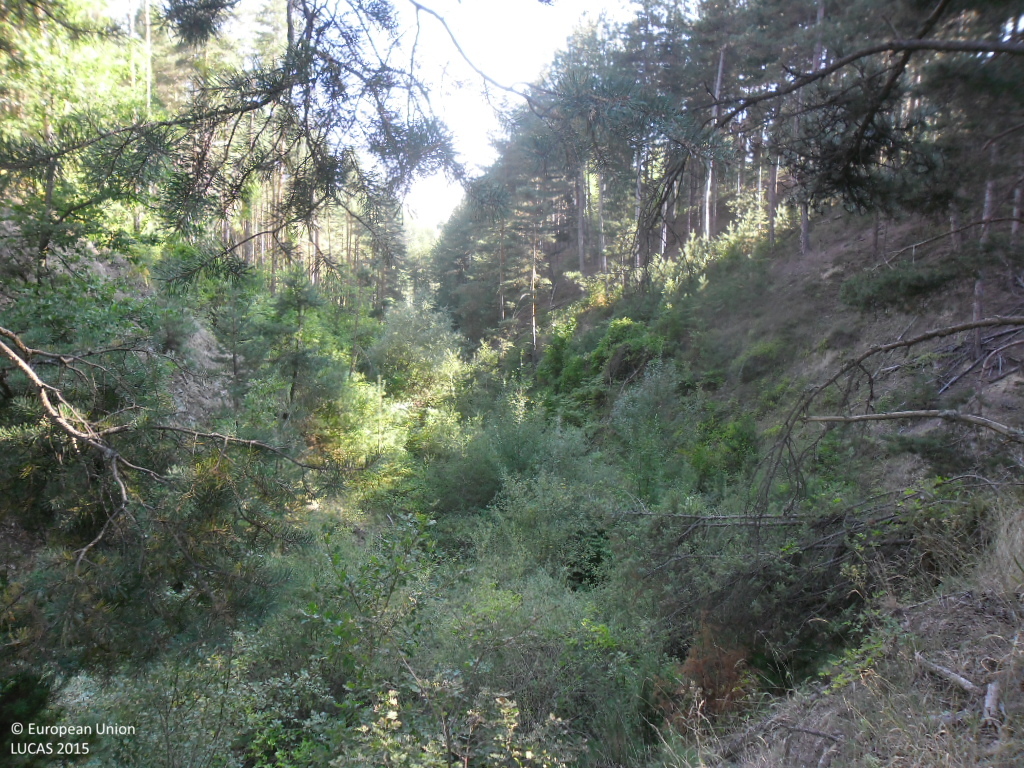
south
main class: Woodland
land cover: Pine dominated coniferous woodland
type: hemiboreal forest and nemoral coniferous forest and mixed broadleaved-coniferous forest
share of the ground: > 75 %
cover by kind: coniferous forest trees 100 %
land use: Forestry
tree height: > 5 m
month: September
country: BG
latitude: 41.7798
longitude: 23.2463
